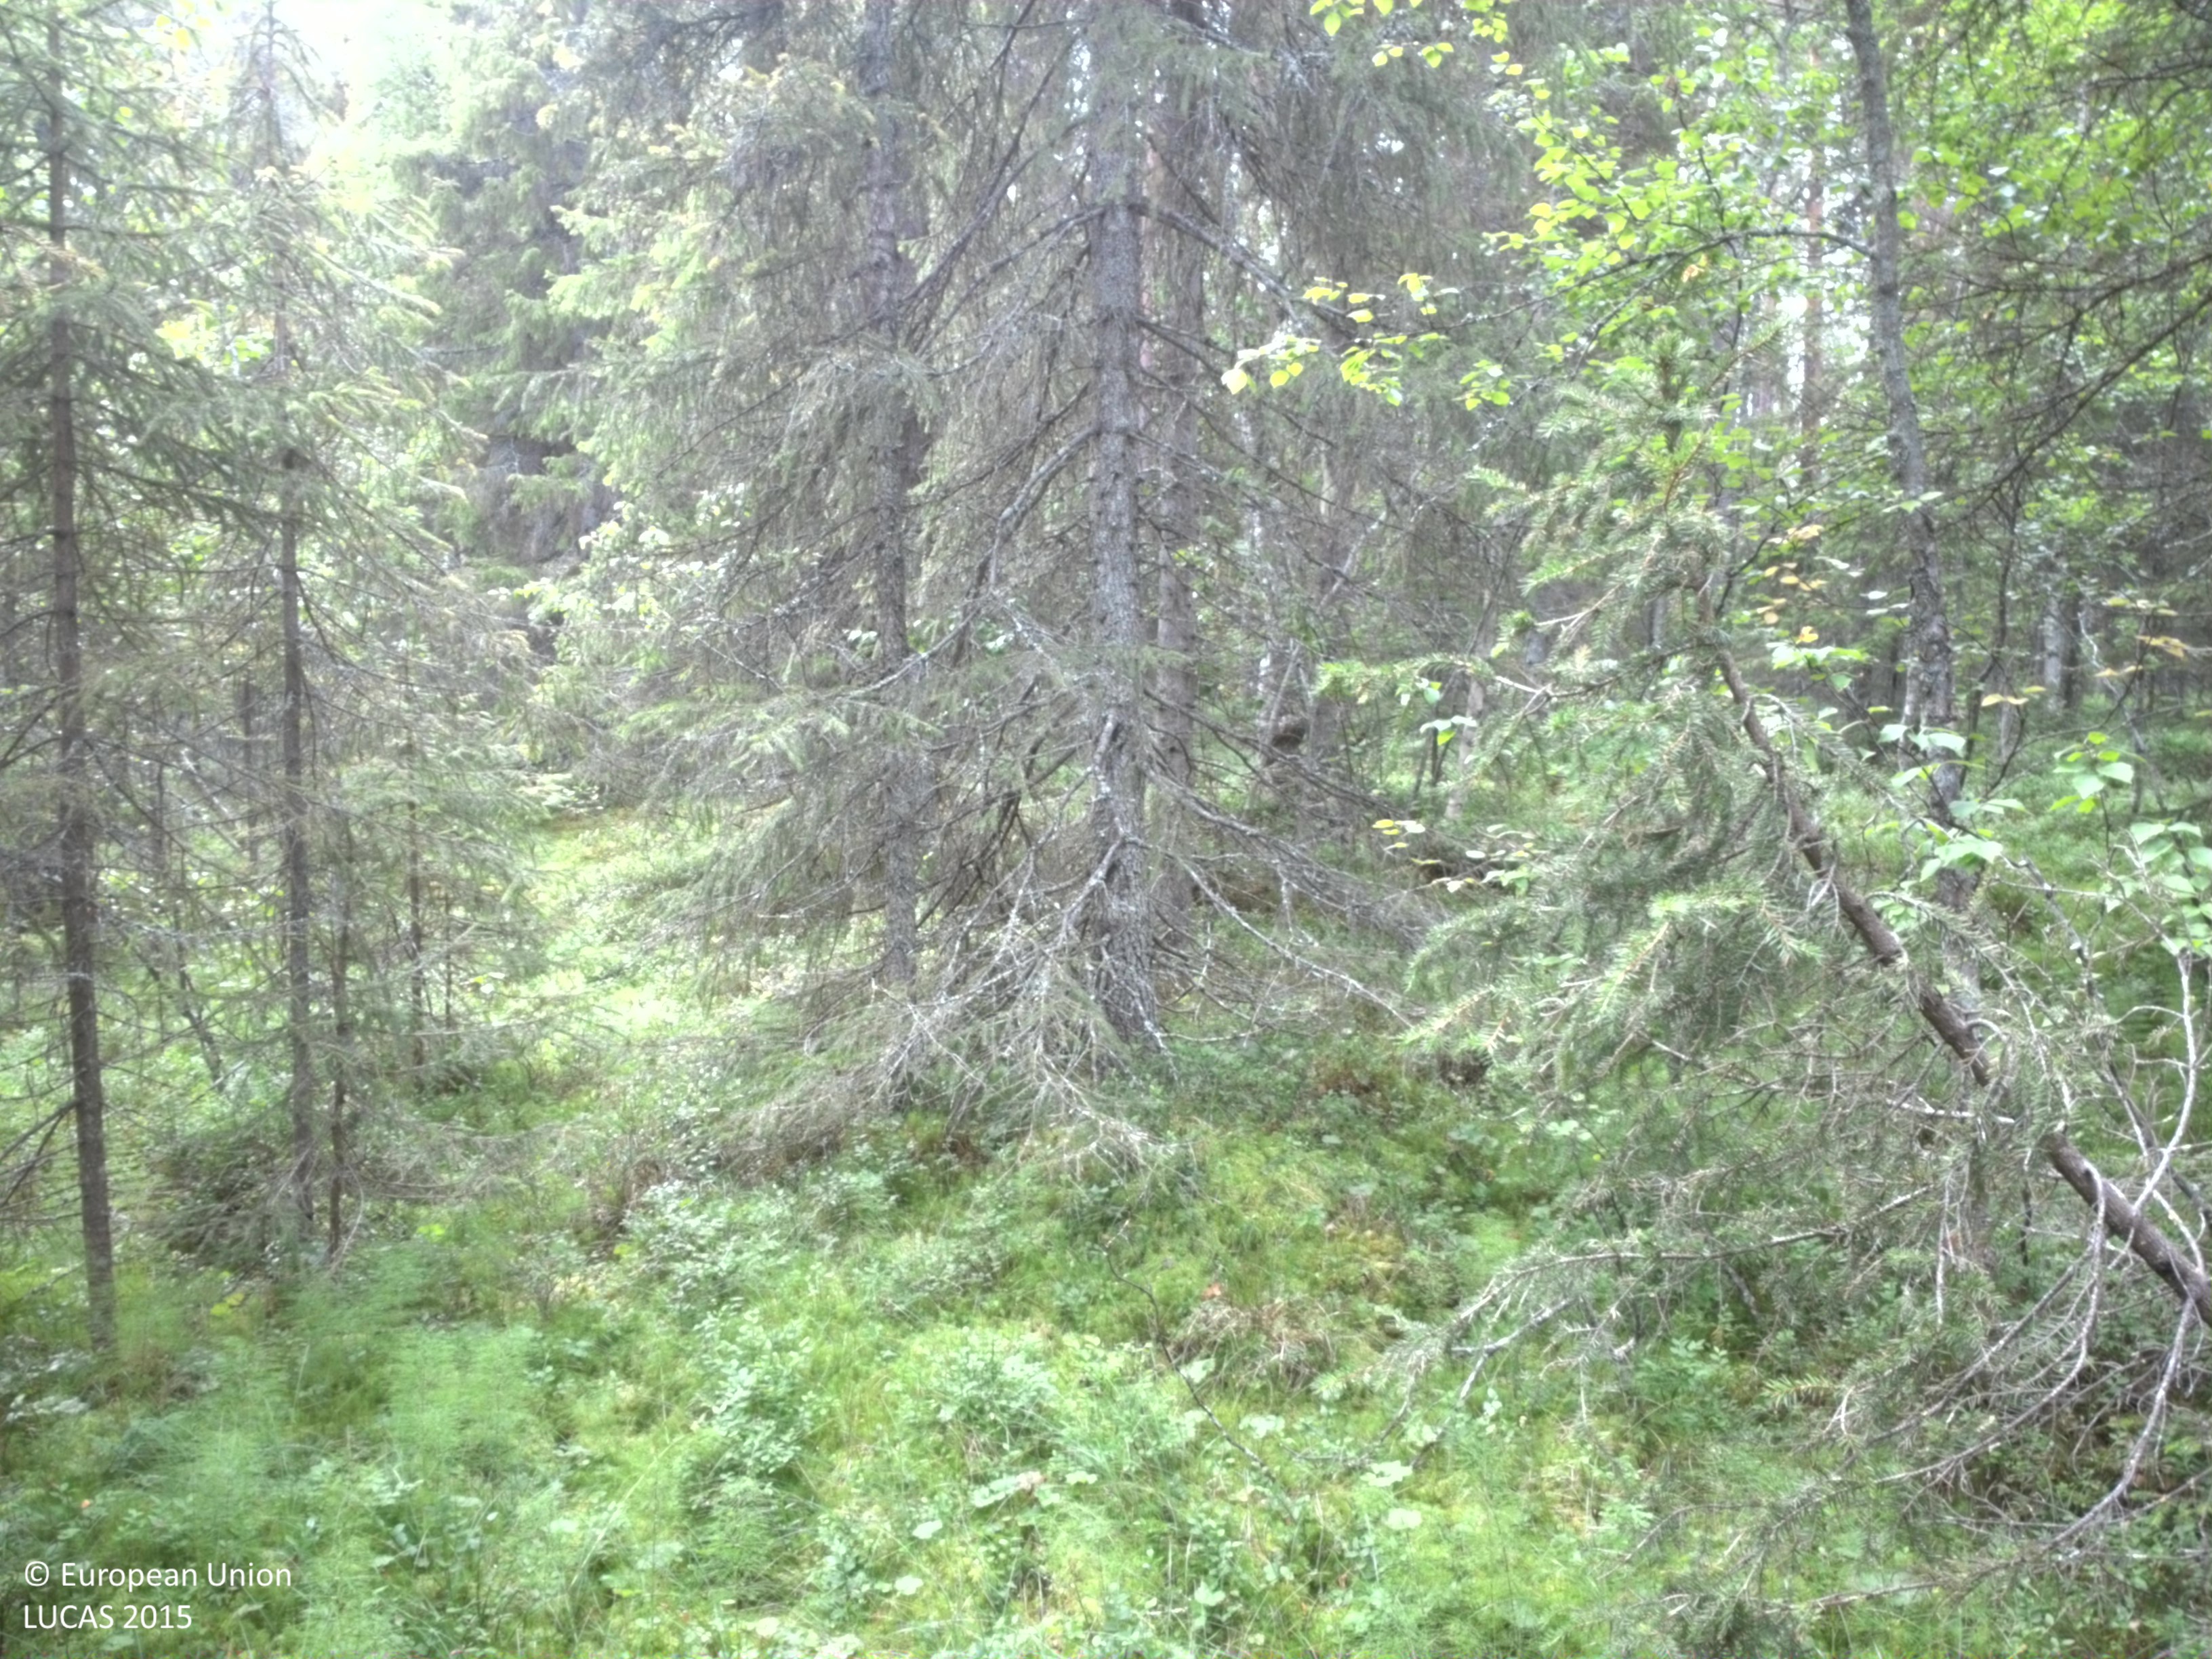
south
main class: Woodland
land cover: Spruce dominated coniferous woodland
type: boreal forest
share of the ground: 50 - 75 %
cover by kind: coniferous forest trees 60 %, shrubs 15 %, herbaceous plants 10 %, lichens and mosses 10 %, broadleaved forest trees 5 %
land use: Forestry
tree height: > 5 m
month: August
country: SE
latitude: 64.5450
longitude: 20.1717
